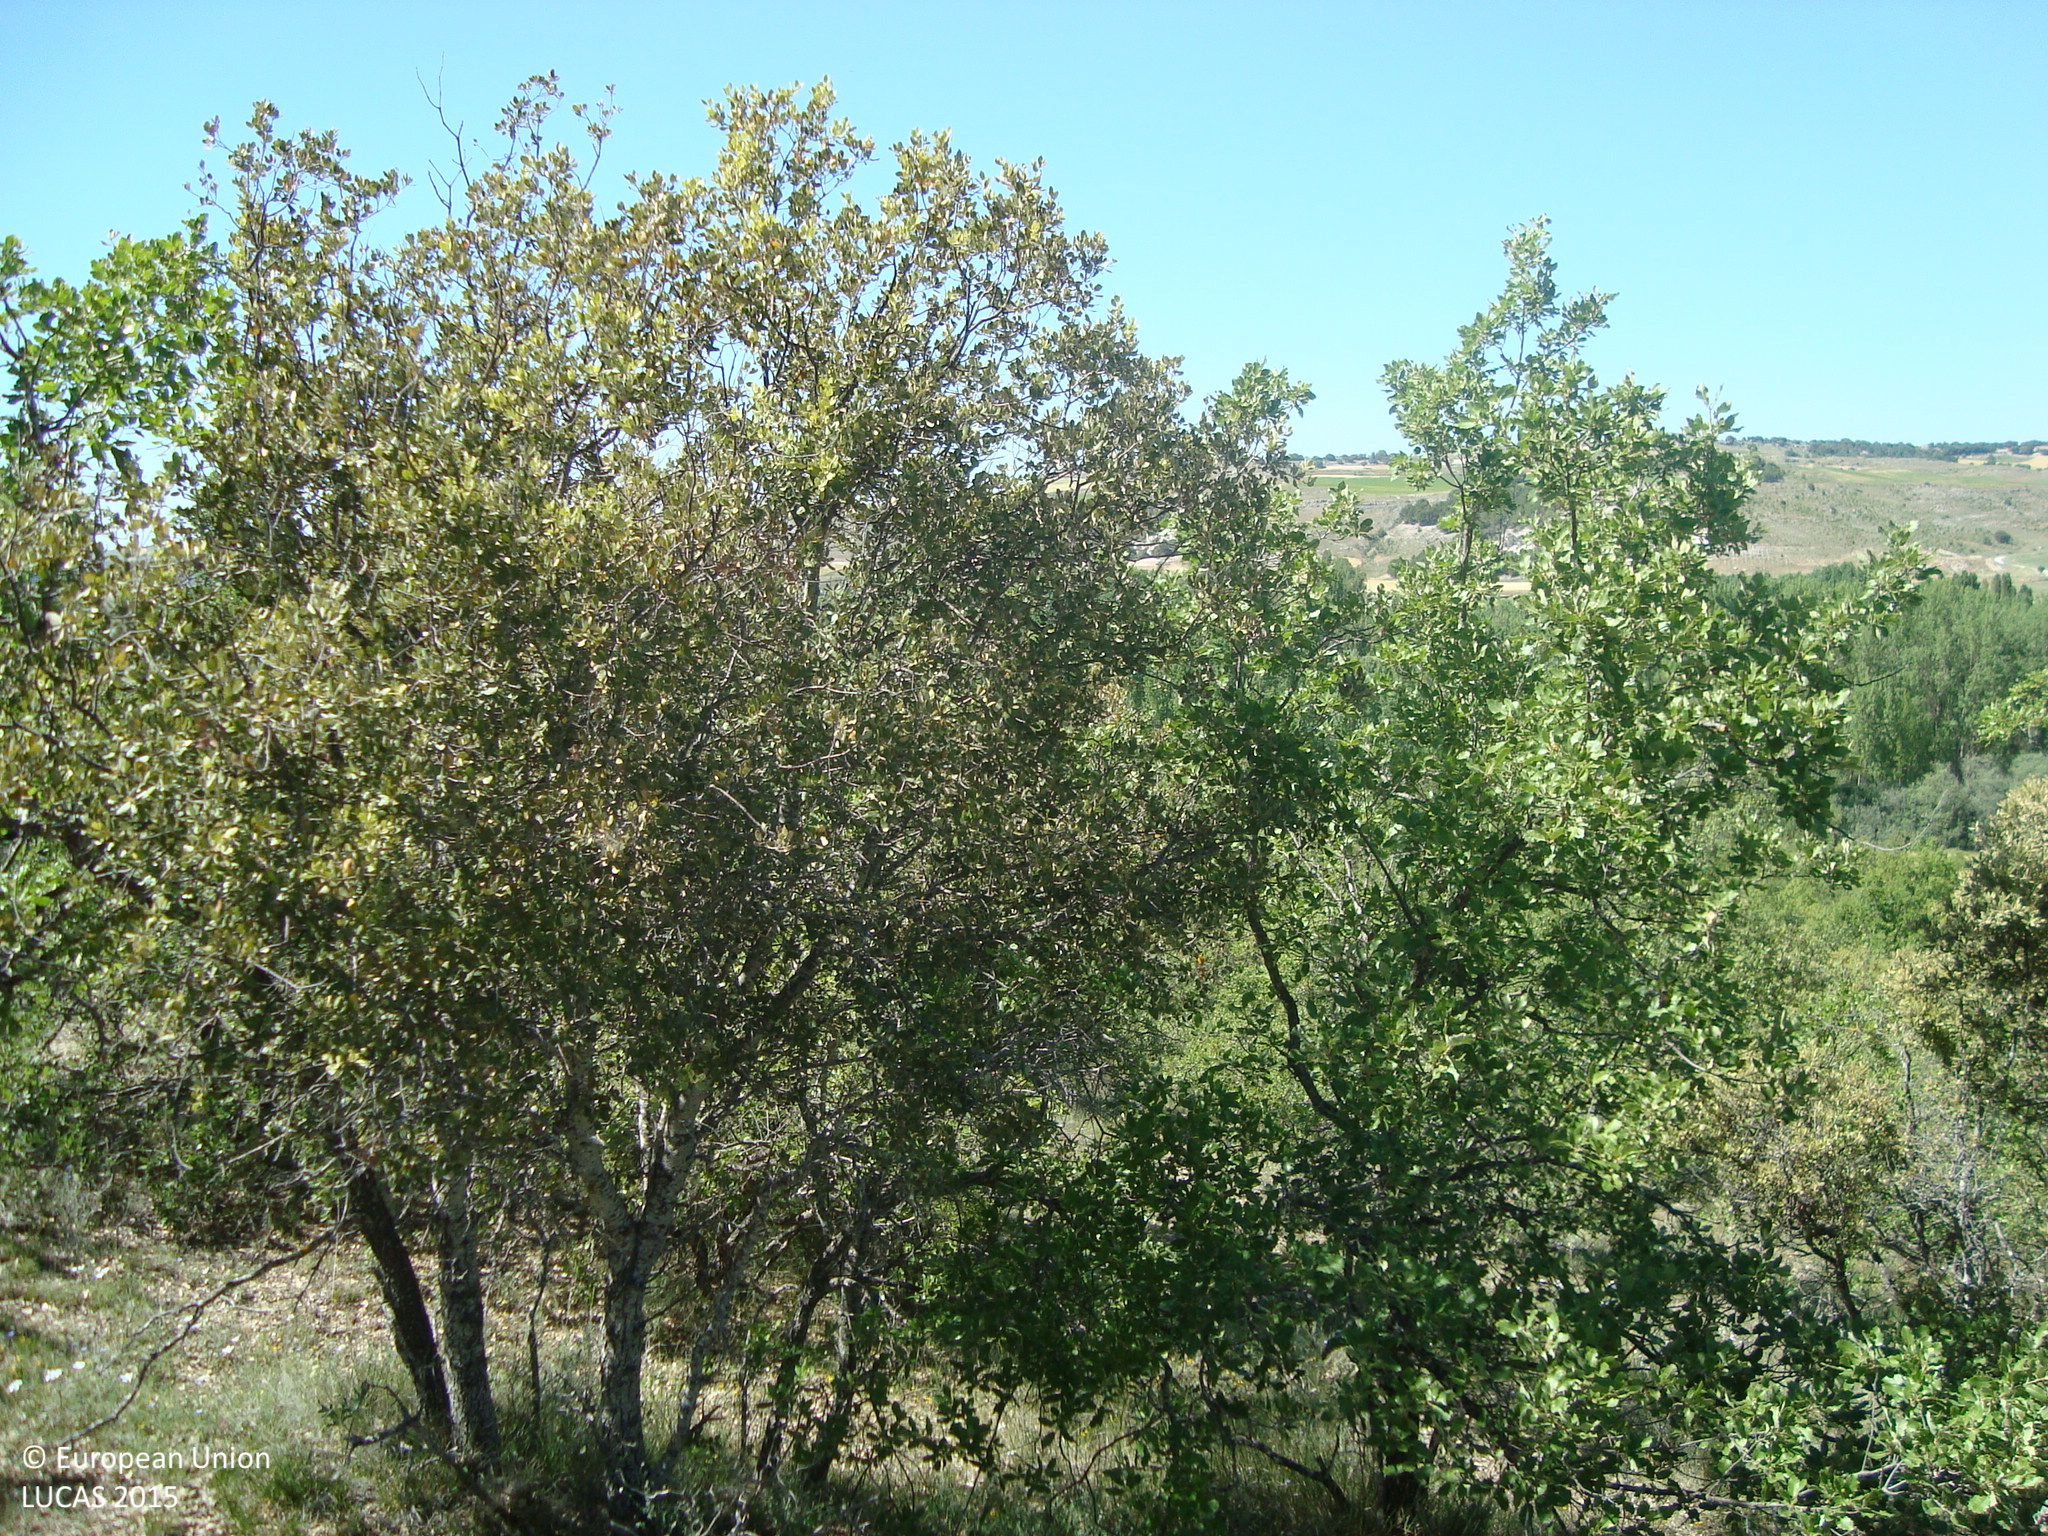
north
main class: Woodland
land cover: Broadleaved woodland
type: thermophilous deciduous forest
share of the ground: 50 - 75 %
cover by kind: broadleaved forest trees 55 %, herbaceous plants 25 %, shrubs 20 %
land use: Semi-natural and natural areas not in use
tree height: < 5 m
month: May
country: ES
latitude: 41.5062
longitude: -4.0374
